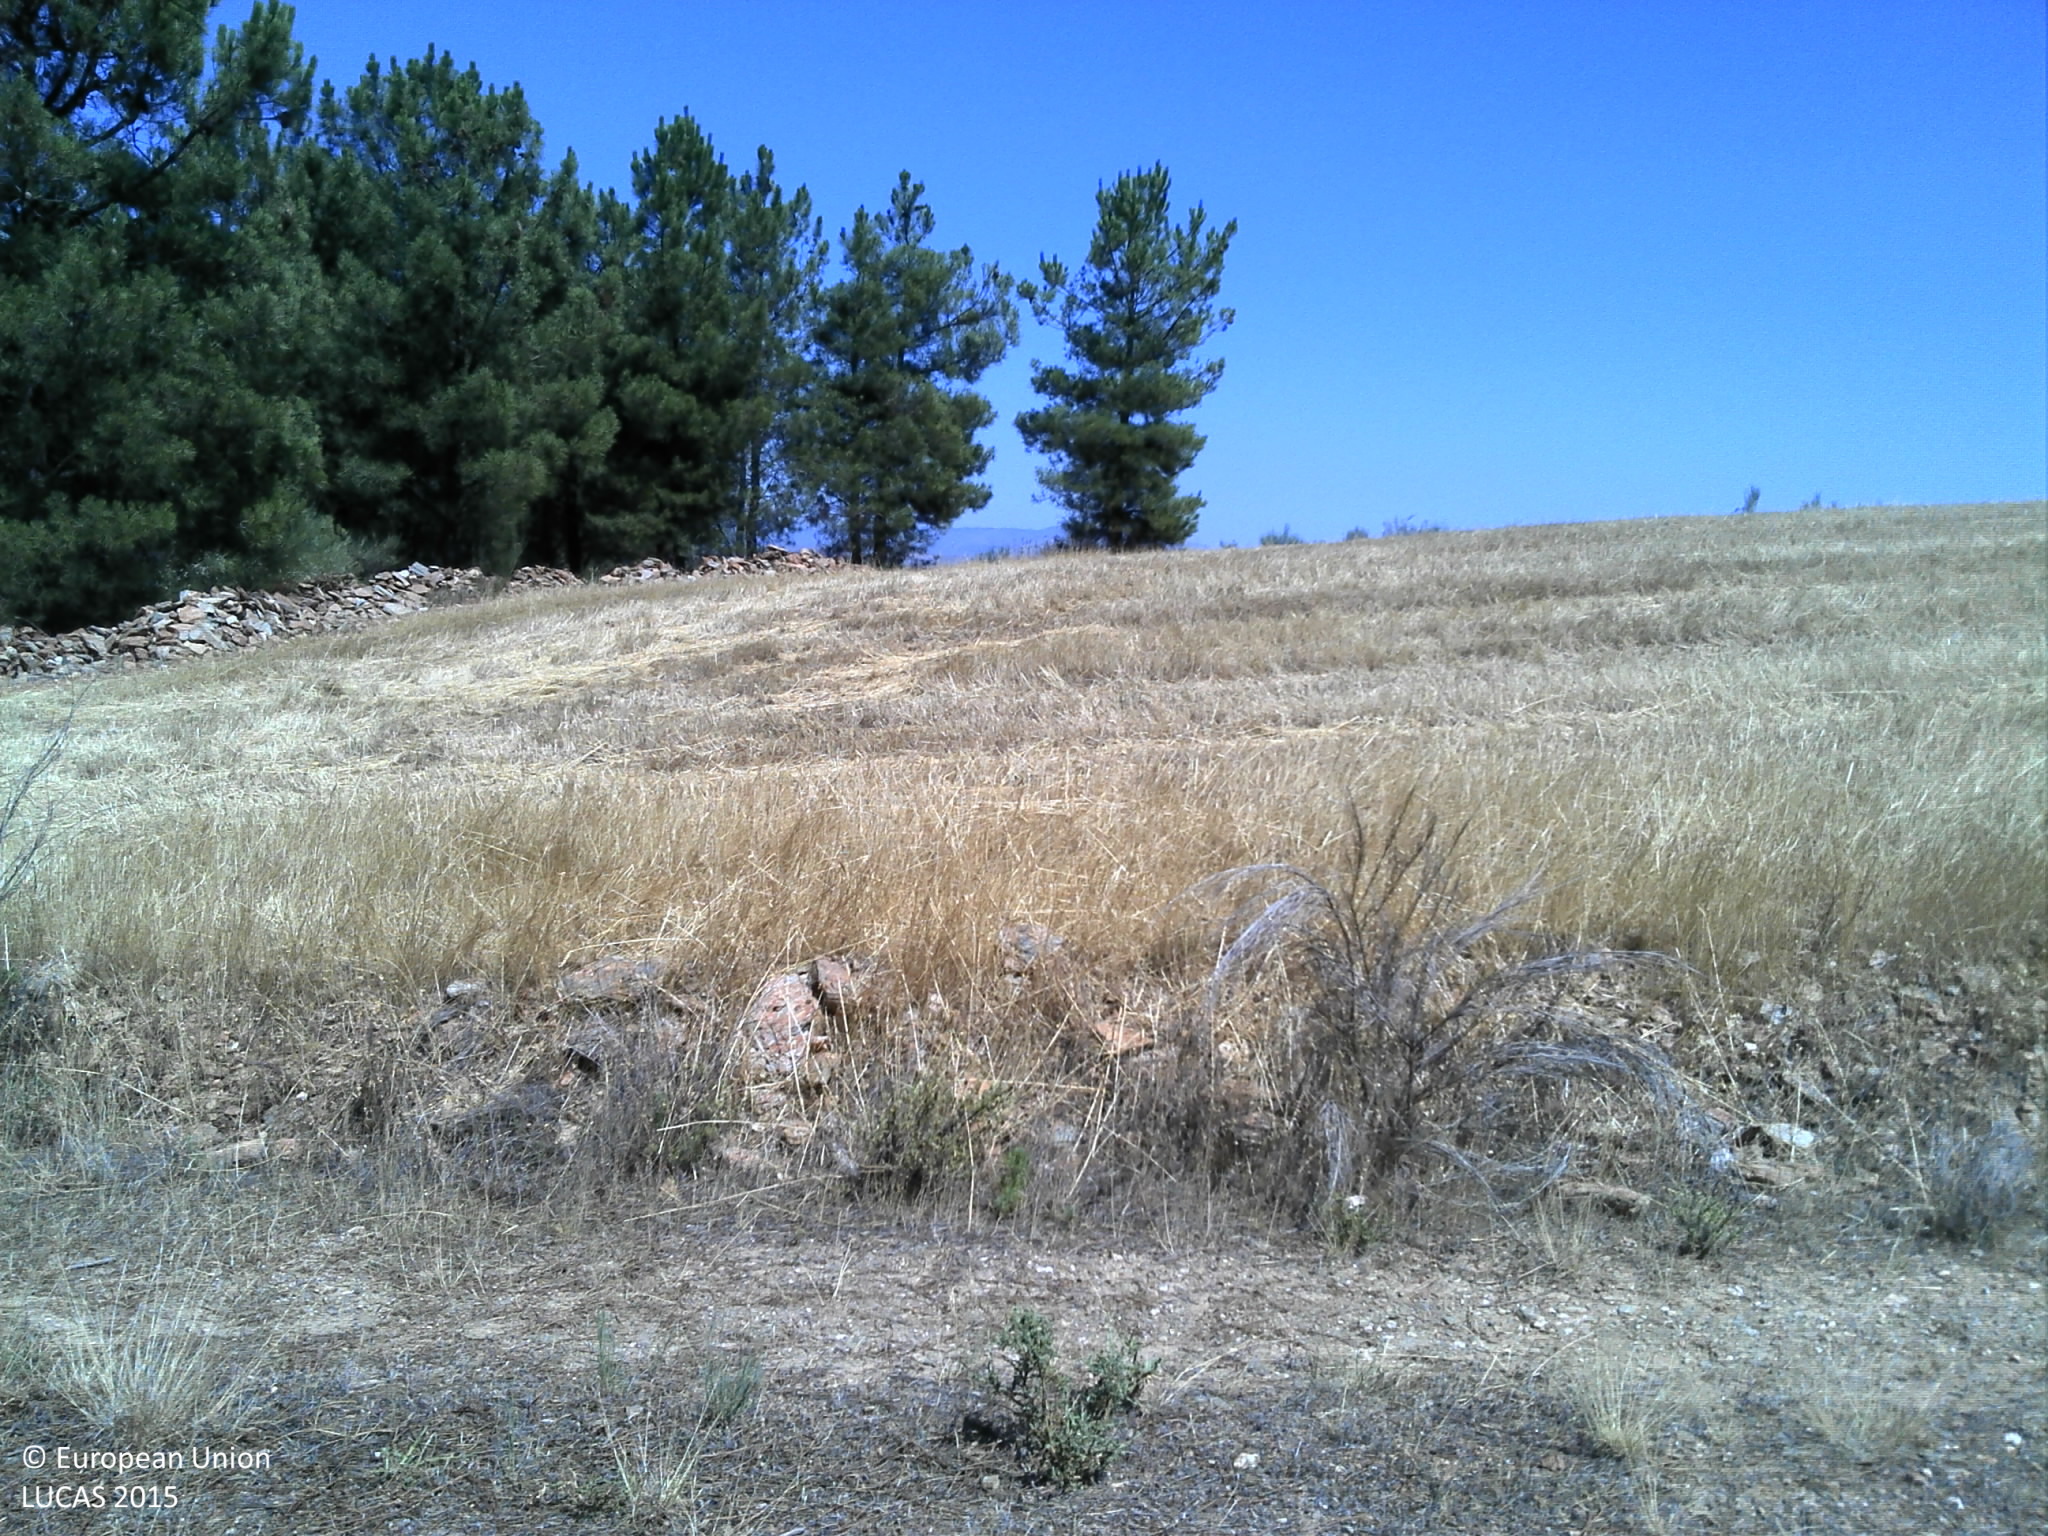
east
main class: Shrubland
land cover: Shrubland with sparse tree cover
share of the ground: > 75 %
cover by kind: shrubs 85 %, herbaceous plants 10 %, coniferous forest trees 5 %
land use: Abandoned areas
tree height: > 5 m
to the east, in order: Shrubland with sparse tree cover; Tracks; Rye; Pine dominated coniferous woodland; Rye; Shrubland with sparse tree cover; Tracks; Shruby margins; Olive groves; Shruby margins; Dry stone walls; Nuts trees; Tracks; Shrubland without tree cover; Grassland without tree/shrub cover
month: July
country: PT
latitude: 41.4730
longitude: -7.2560
